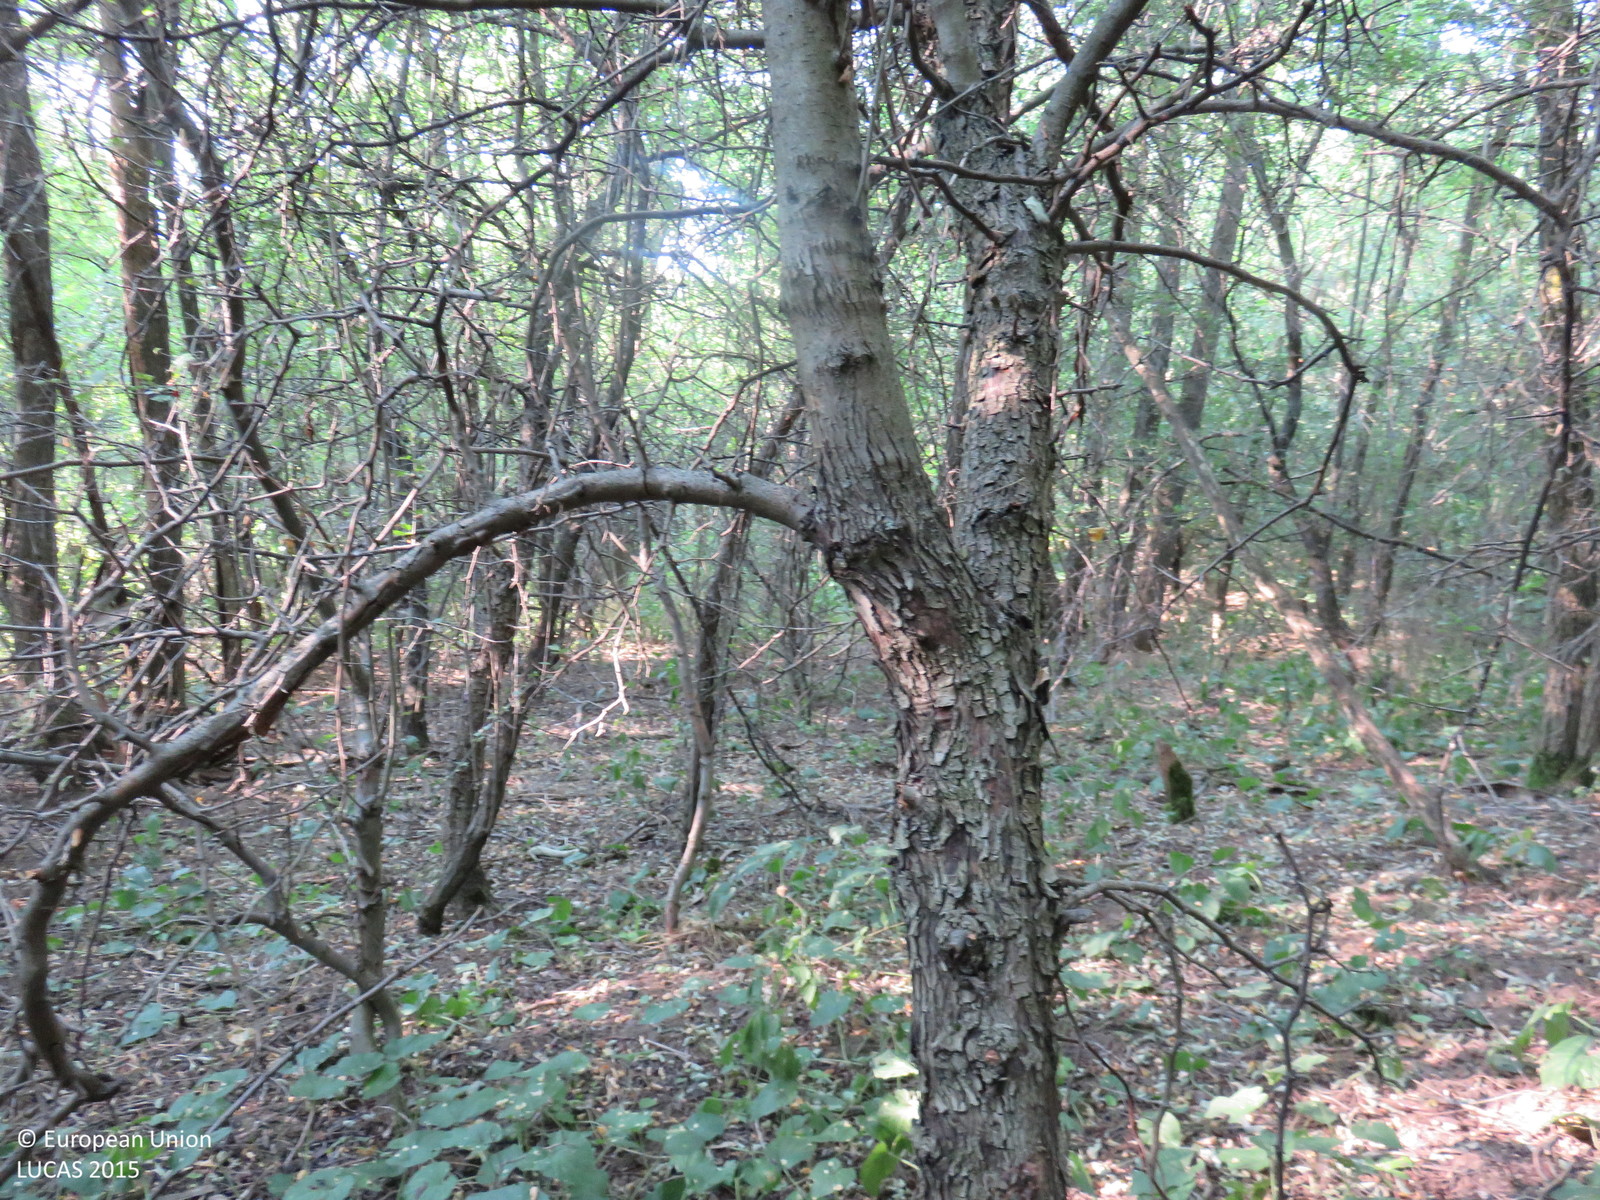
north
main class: Woodland
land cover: Broadleaved woodland
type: mesophytic deciduous forest
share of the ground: > 75 %
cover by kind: broadleaved forest trees 95 %, shrubs 5 %
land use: Forestry
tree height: > 5 m
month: July
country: BG
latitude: 43.5938
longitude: 25.0486
